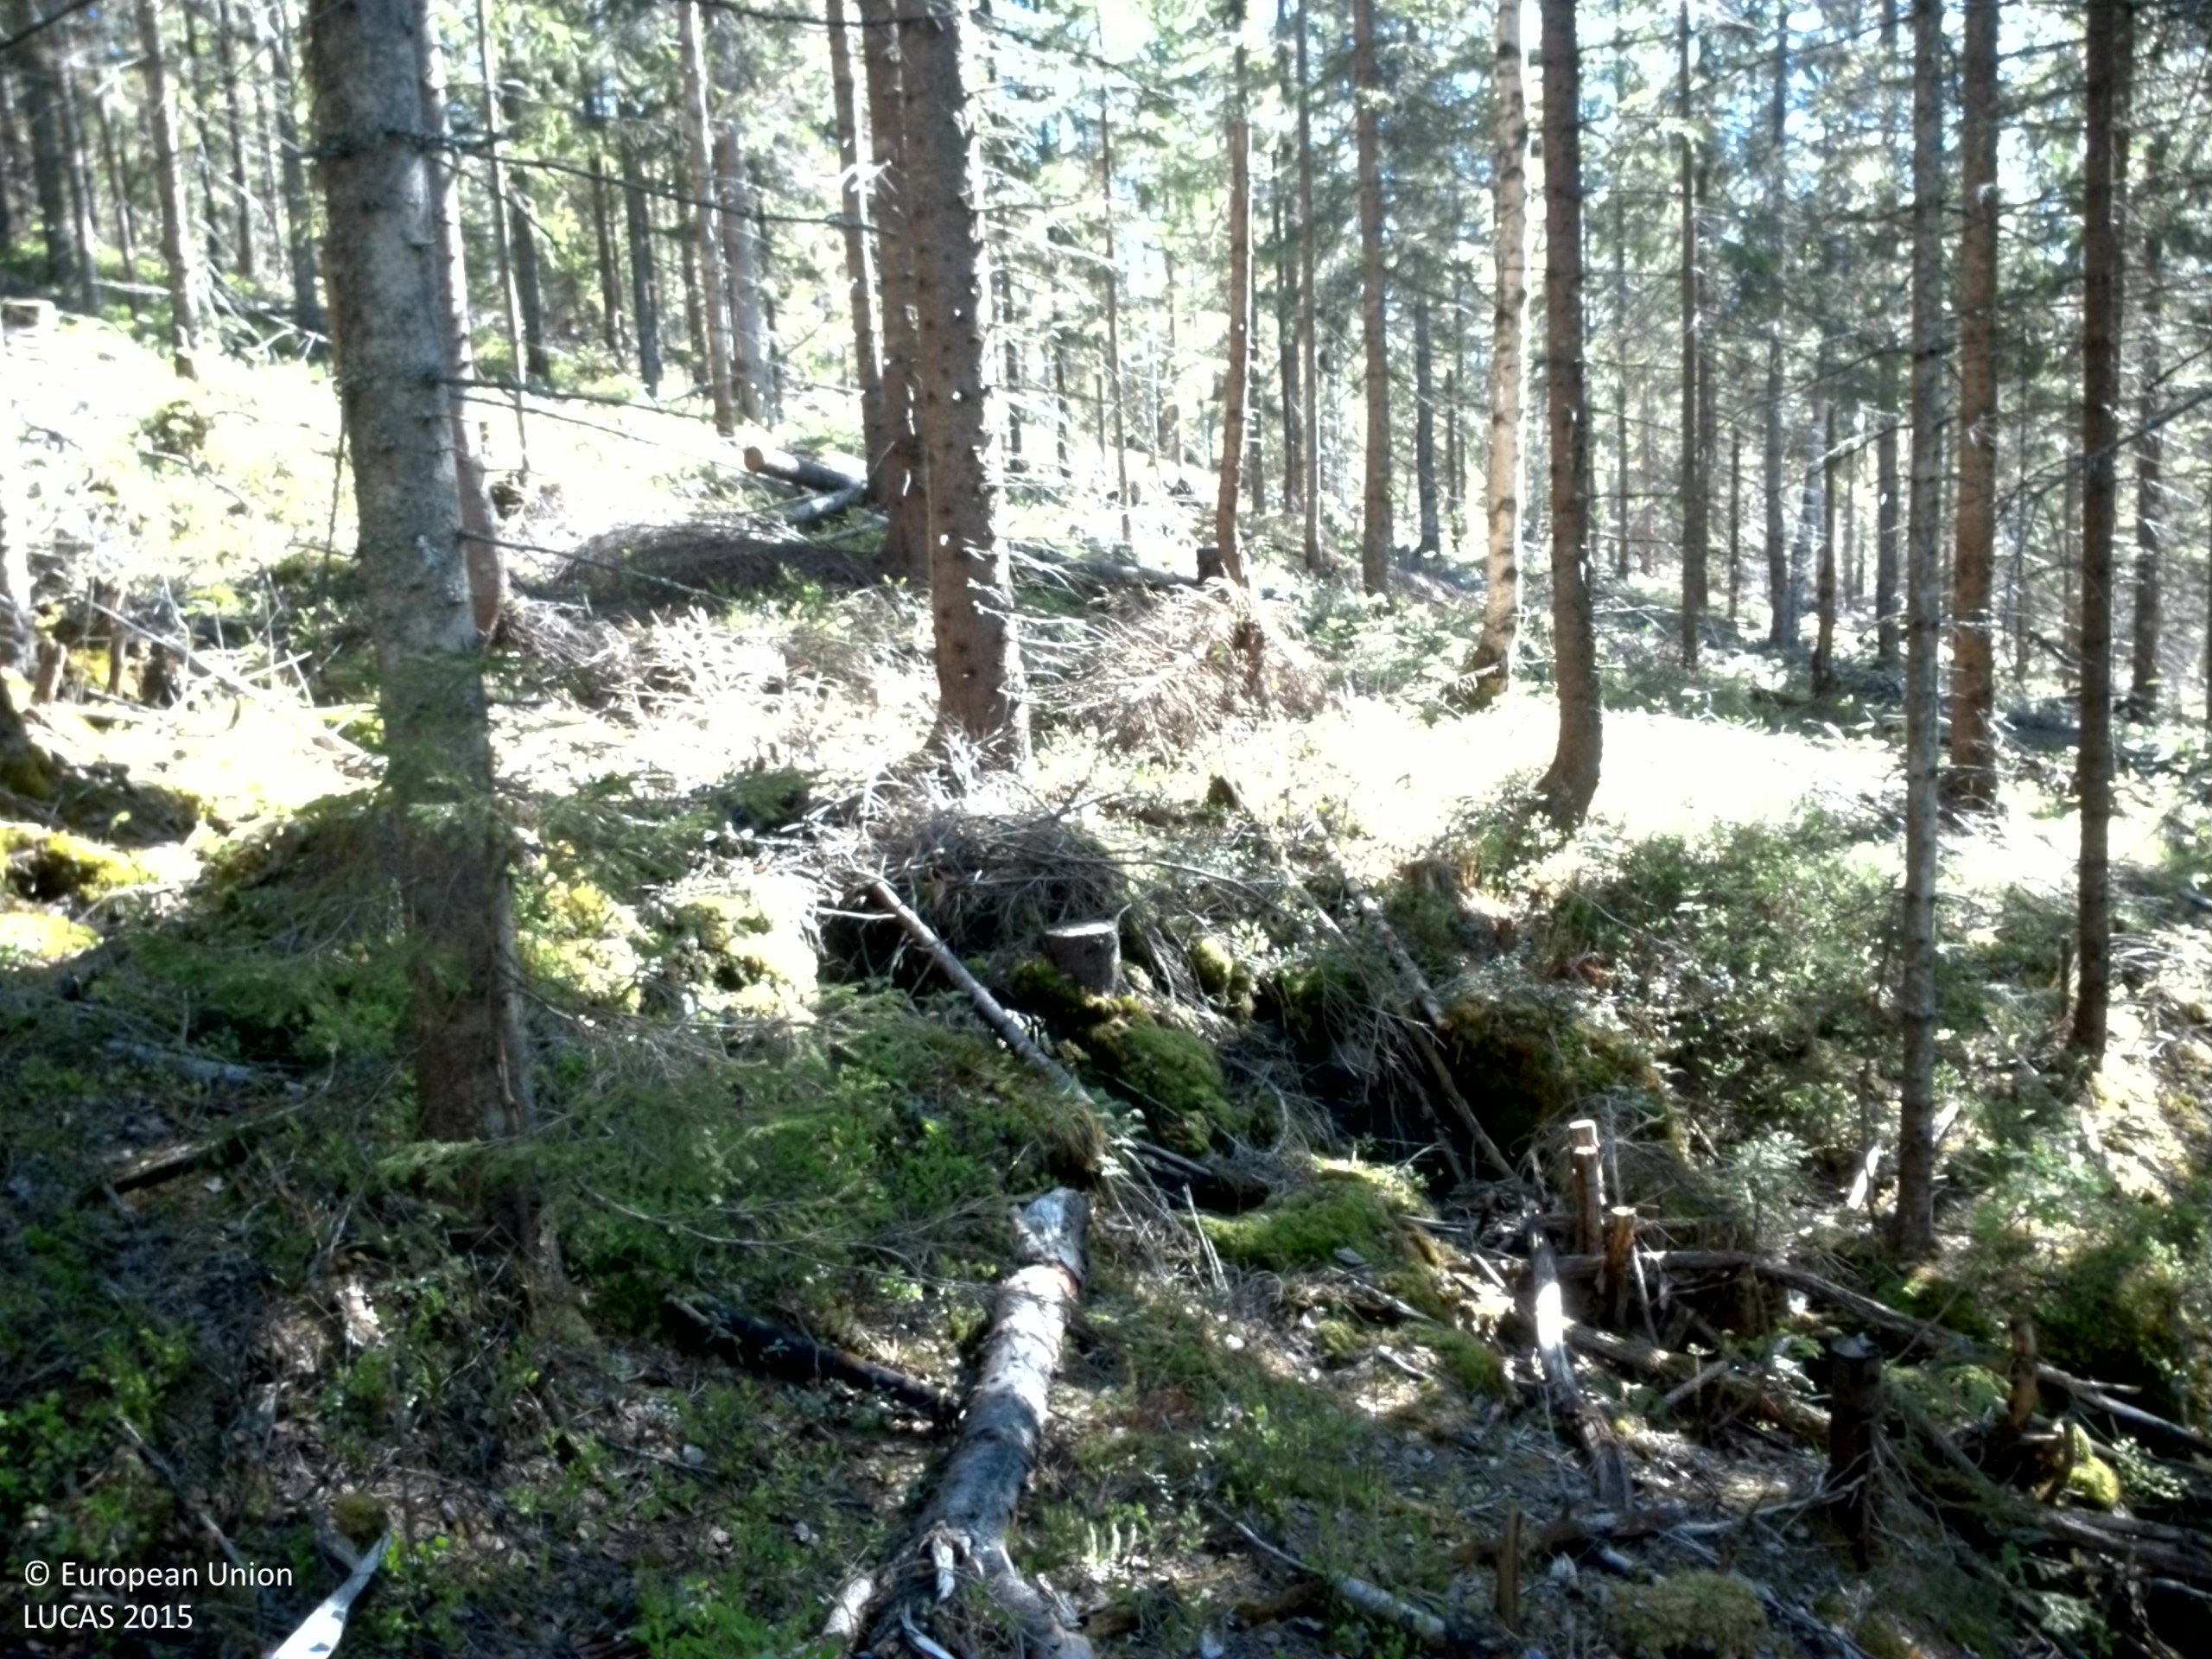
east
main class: Woodland
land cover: Spruce dominated coniferous woodland
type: boreal forest
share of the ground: 25 - 50 %
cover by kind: coniferous forest trees 50 %, shrubs 20 %, lichens and mosses 10 %
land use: Forestry
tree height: > 5 m
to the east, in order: Spruce dominated coniferous woodland; Spruce dominated mixed woodland
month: May
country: SE
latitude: 63.0015
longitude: 17.9351
